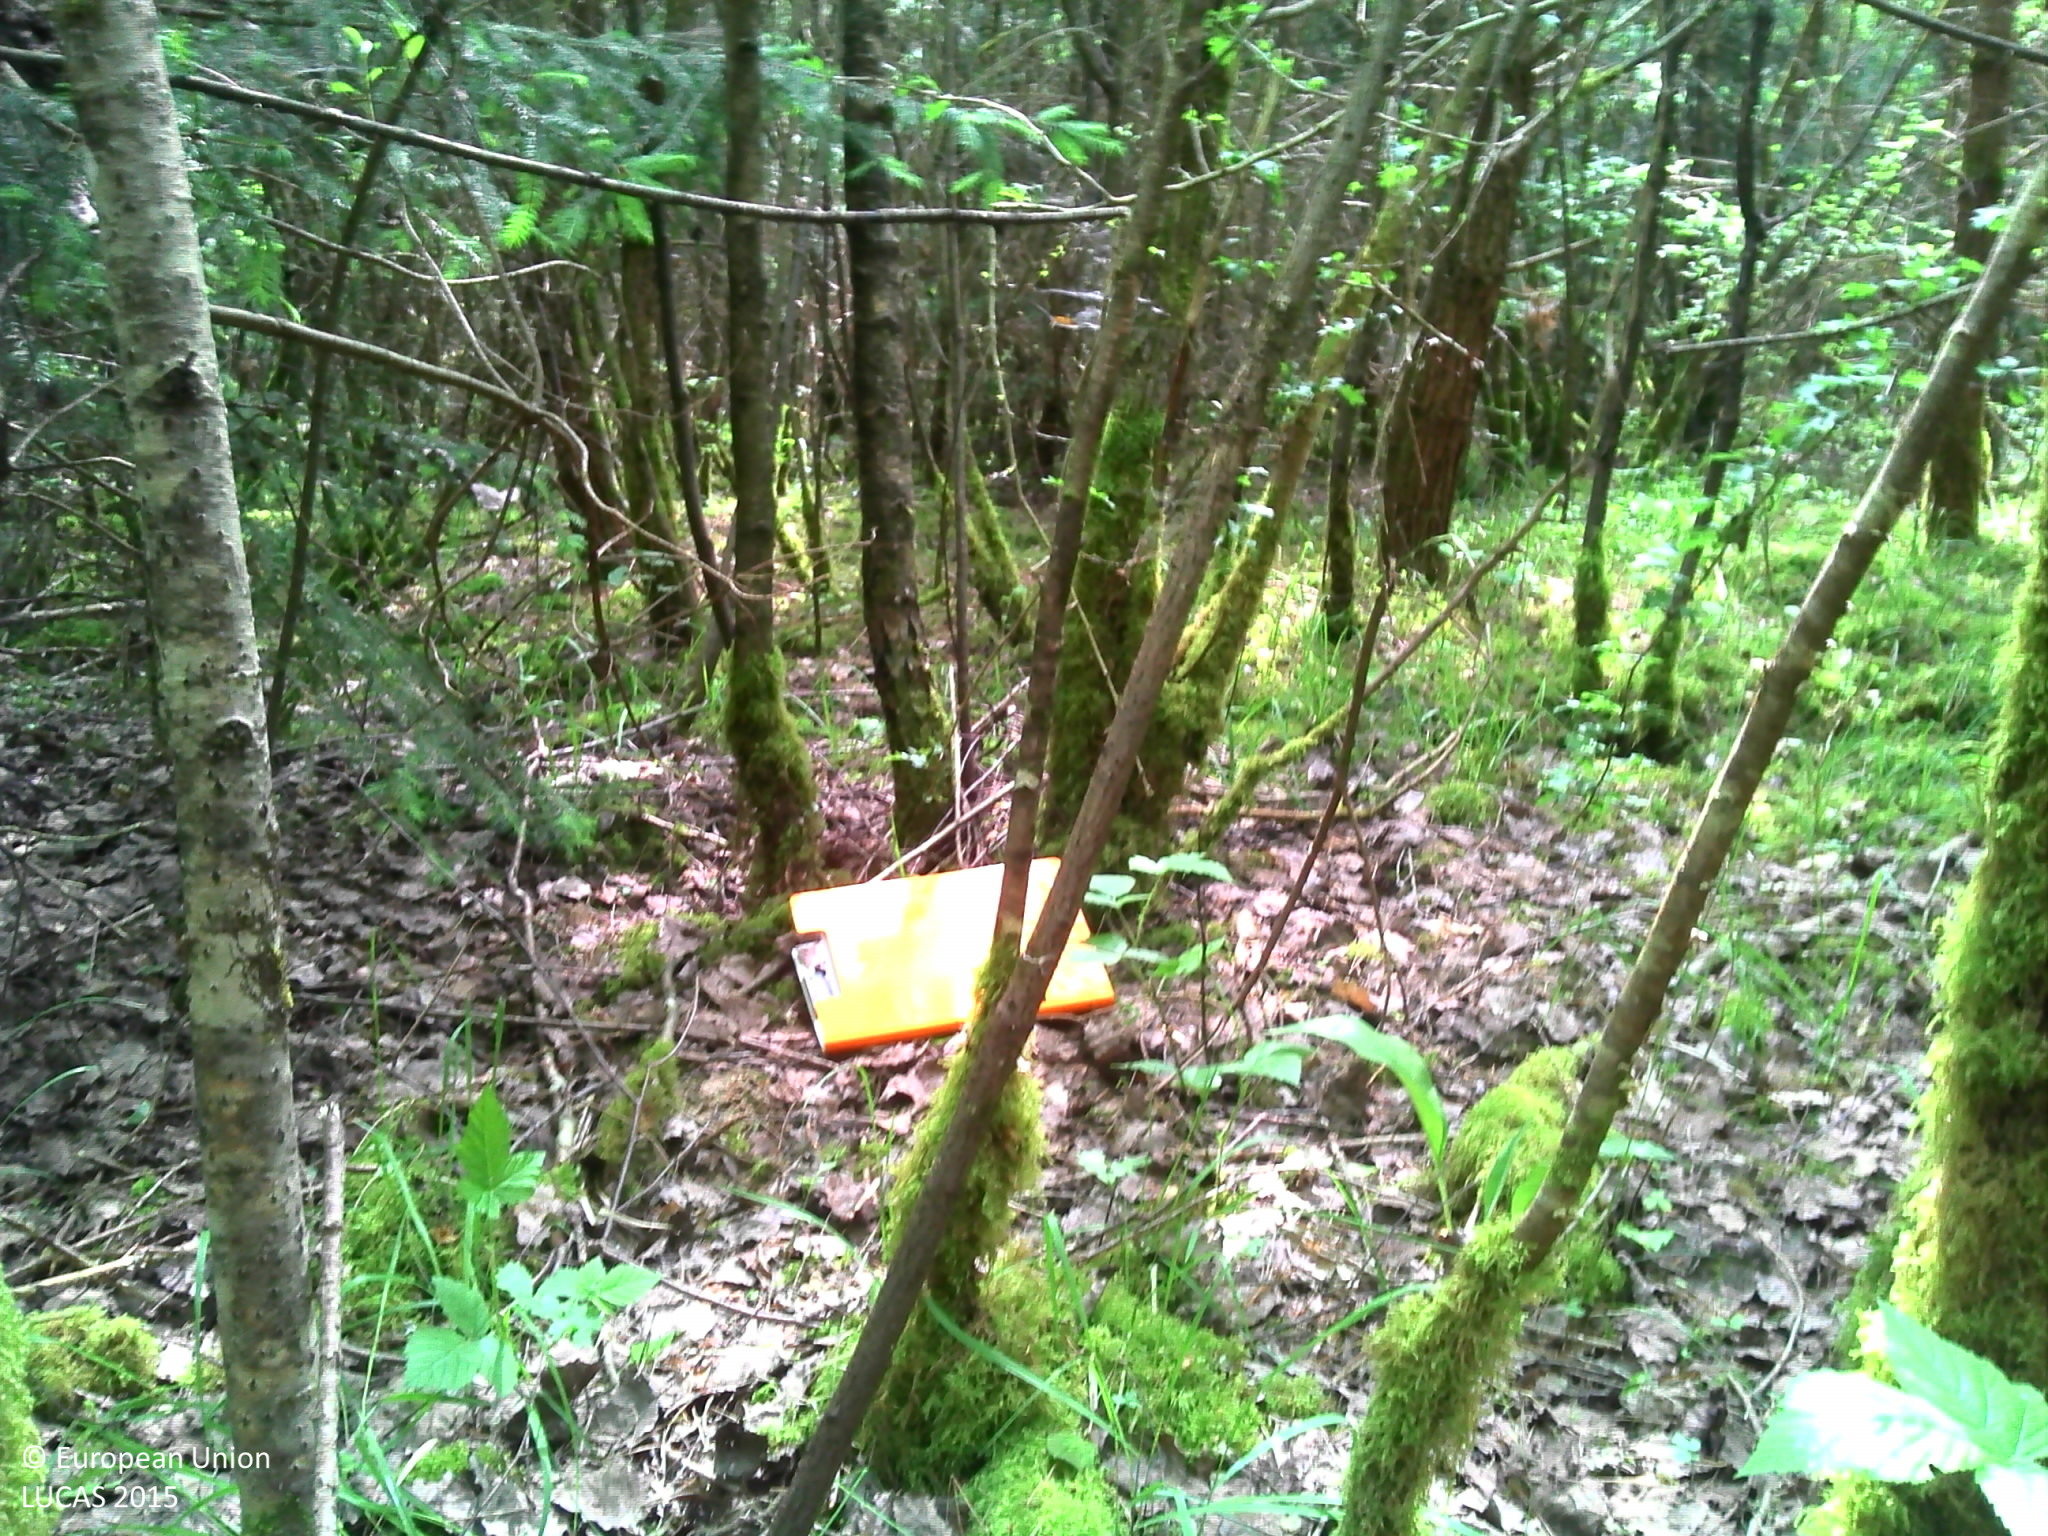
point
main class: Woodland
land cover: Spruce dominated mixed woodland
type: beech forest
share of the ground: > 75 %
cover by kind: coniferous forest trees 45 %, broadleaved forest trees 45 %, herbaceous plants 10 %
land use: Forestry
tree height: > 5 m
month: May
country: FR
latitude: 47.9537
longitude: 6.0237
